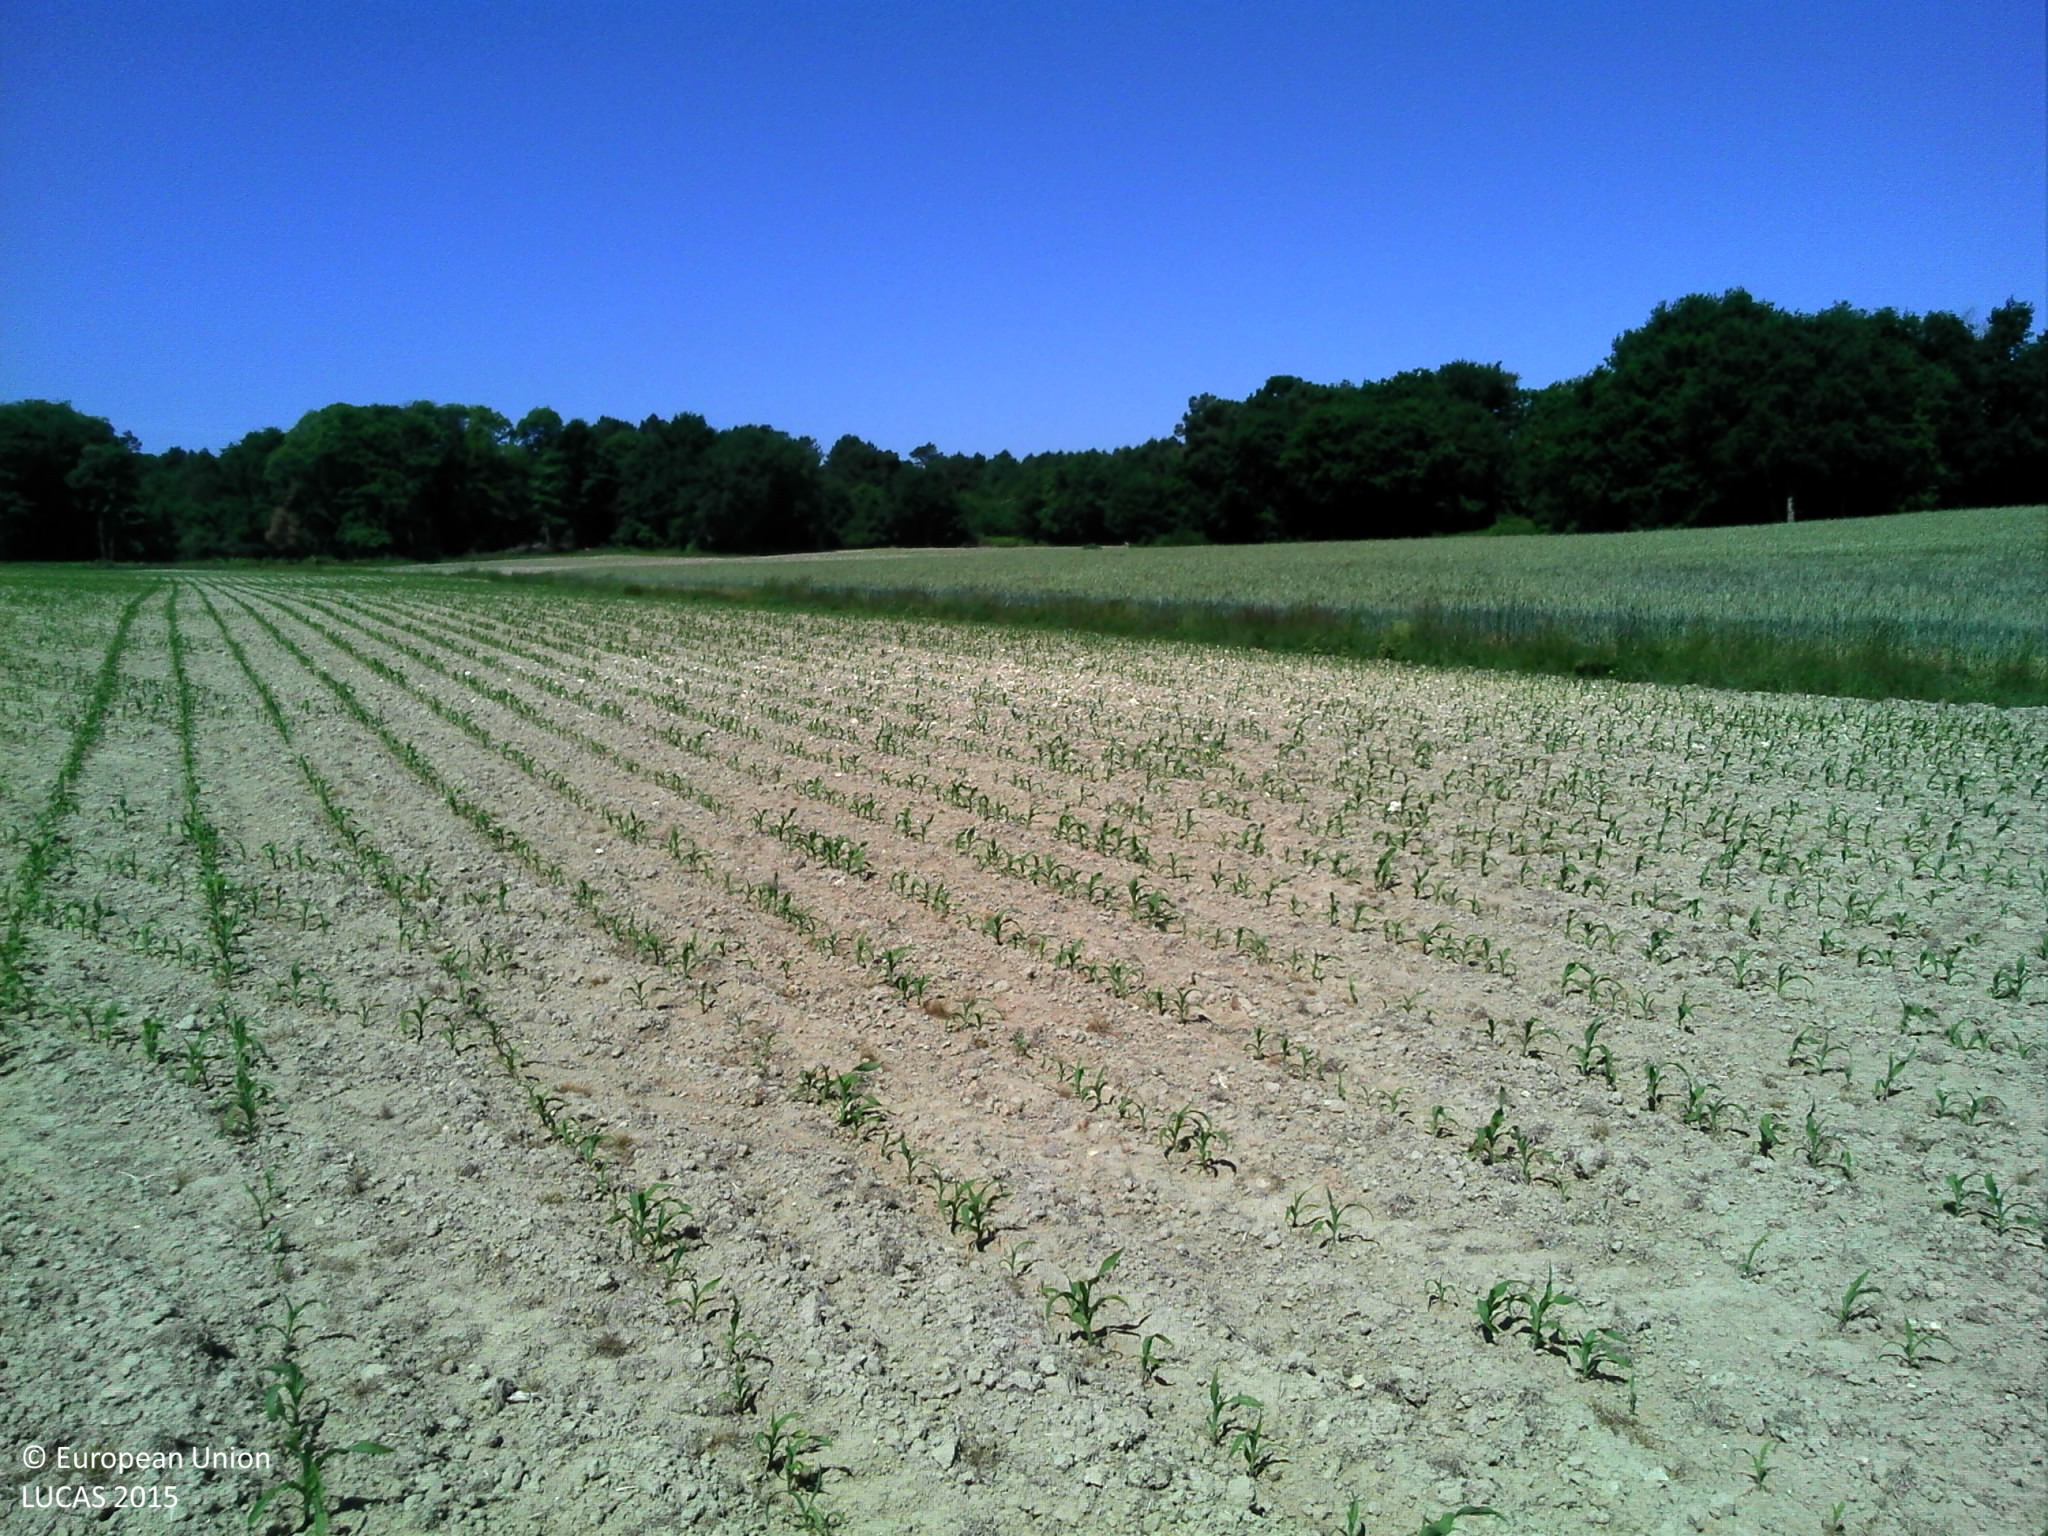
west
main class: Cropland
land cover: Maize
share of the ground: 10 - 25 %
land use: Agriculture (excluding fallow land and kitchen gardens)
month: June
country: FR
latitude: 46.9100
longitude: 0.5413
